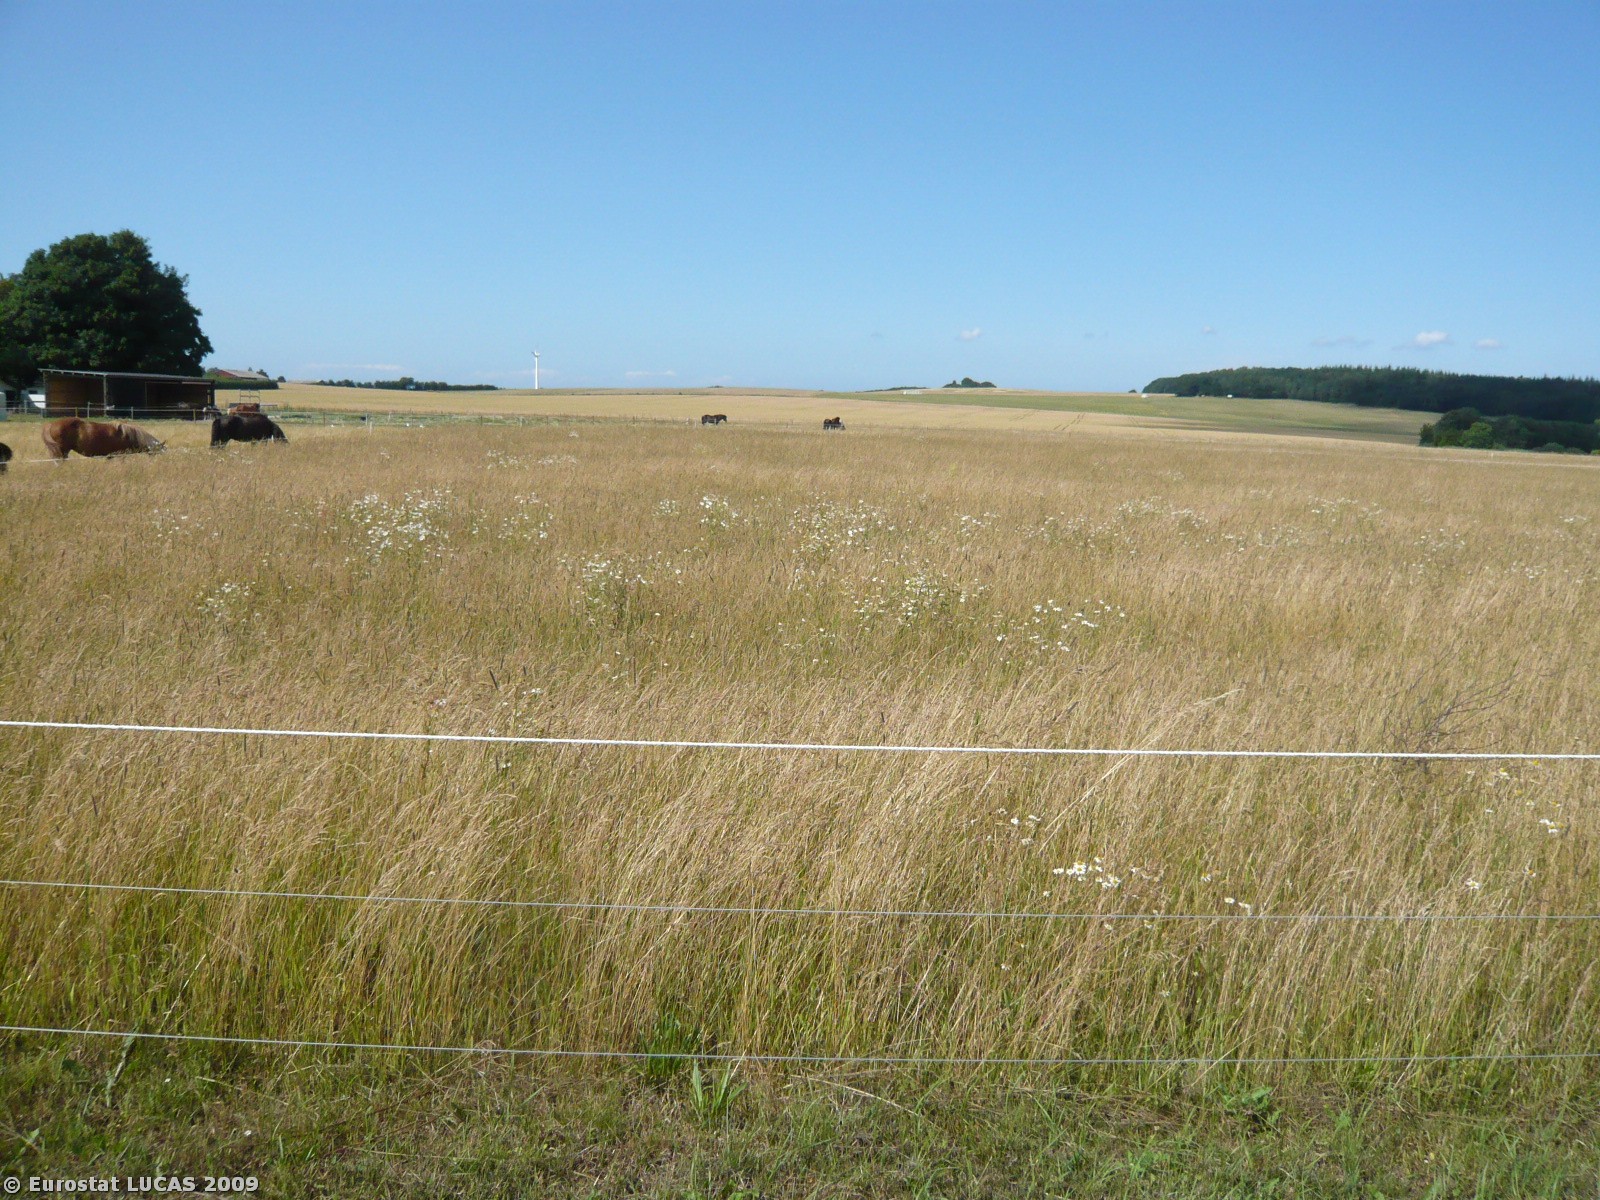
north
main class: Grassland
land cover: Grassland without tree/shrub cover
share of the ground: > 75 %
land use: Agriculture (excluding fallow land and kitchen gardens)
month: July
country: DK
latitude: 55.7625
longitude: 11.7355
